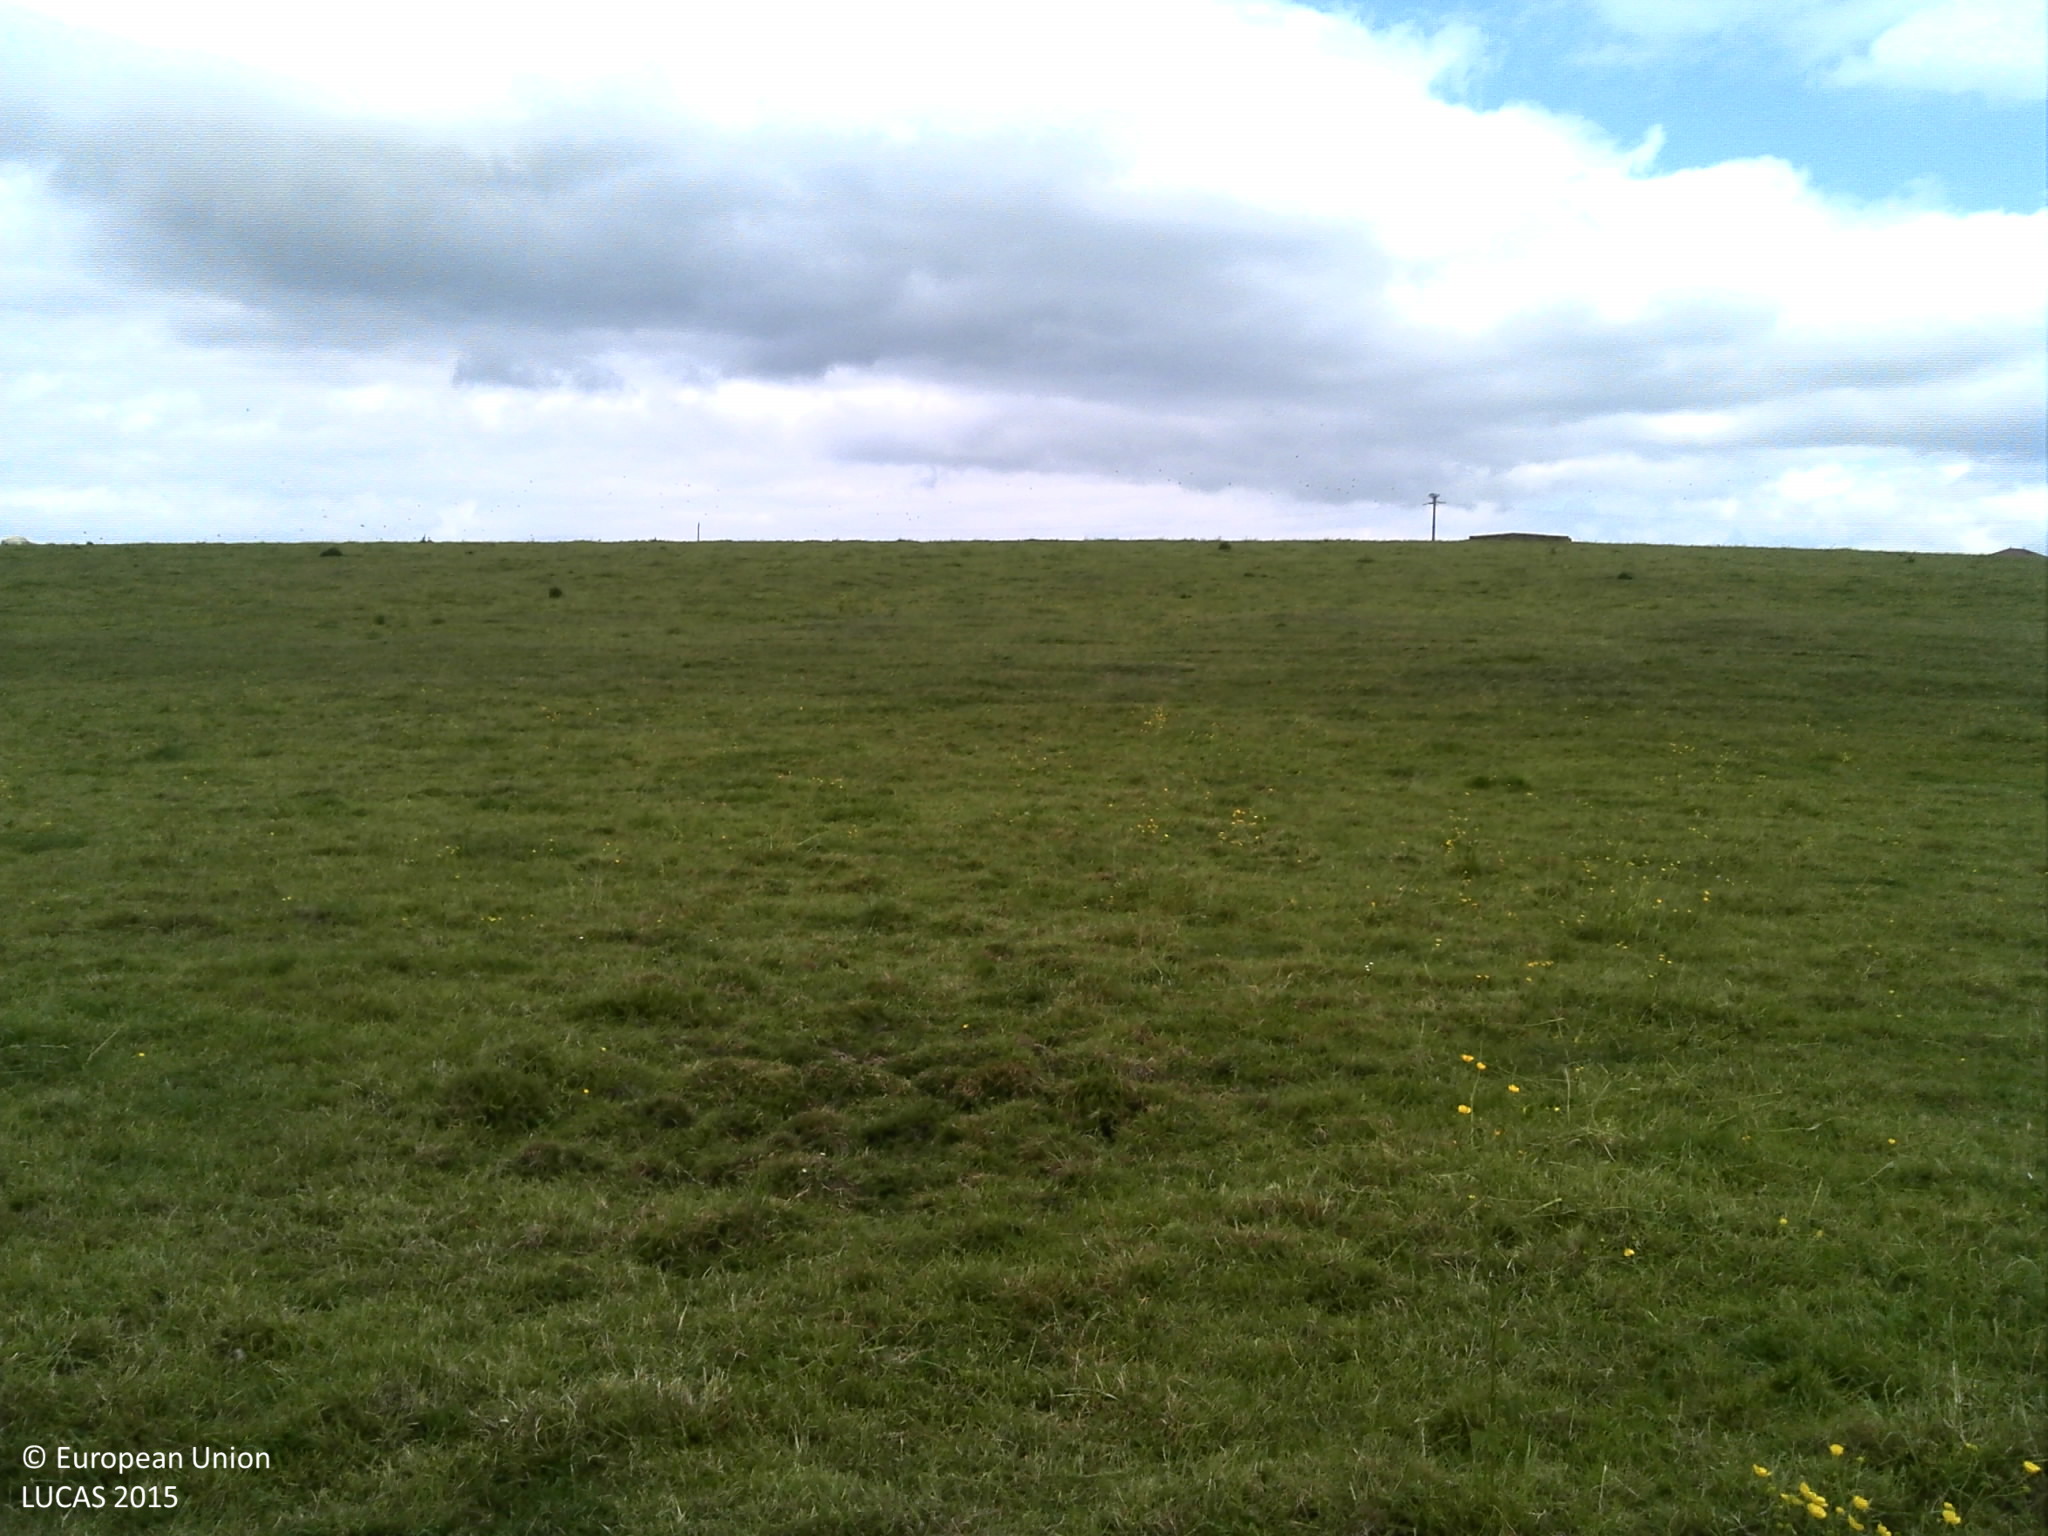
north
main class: Grassland
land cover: Grassland without tree/shrub cover
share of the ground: > 75 %
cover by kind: herbaceous plants 100 %
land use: Agriculture (excluding fallow land and kitchen gardens)
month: June
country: FR
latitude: 49.0428
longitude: 6.2650
